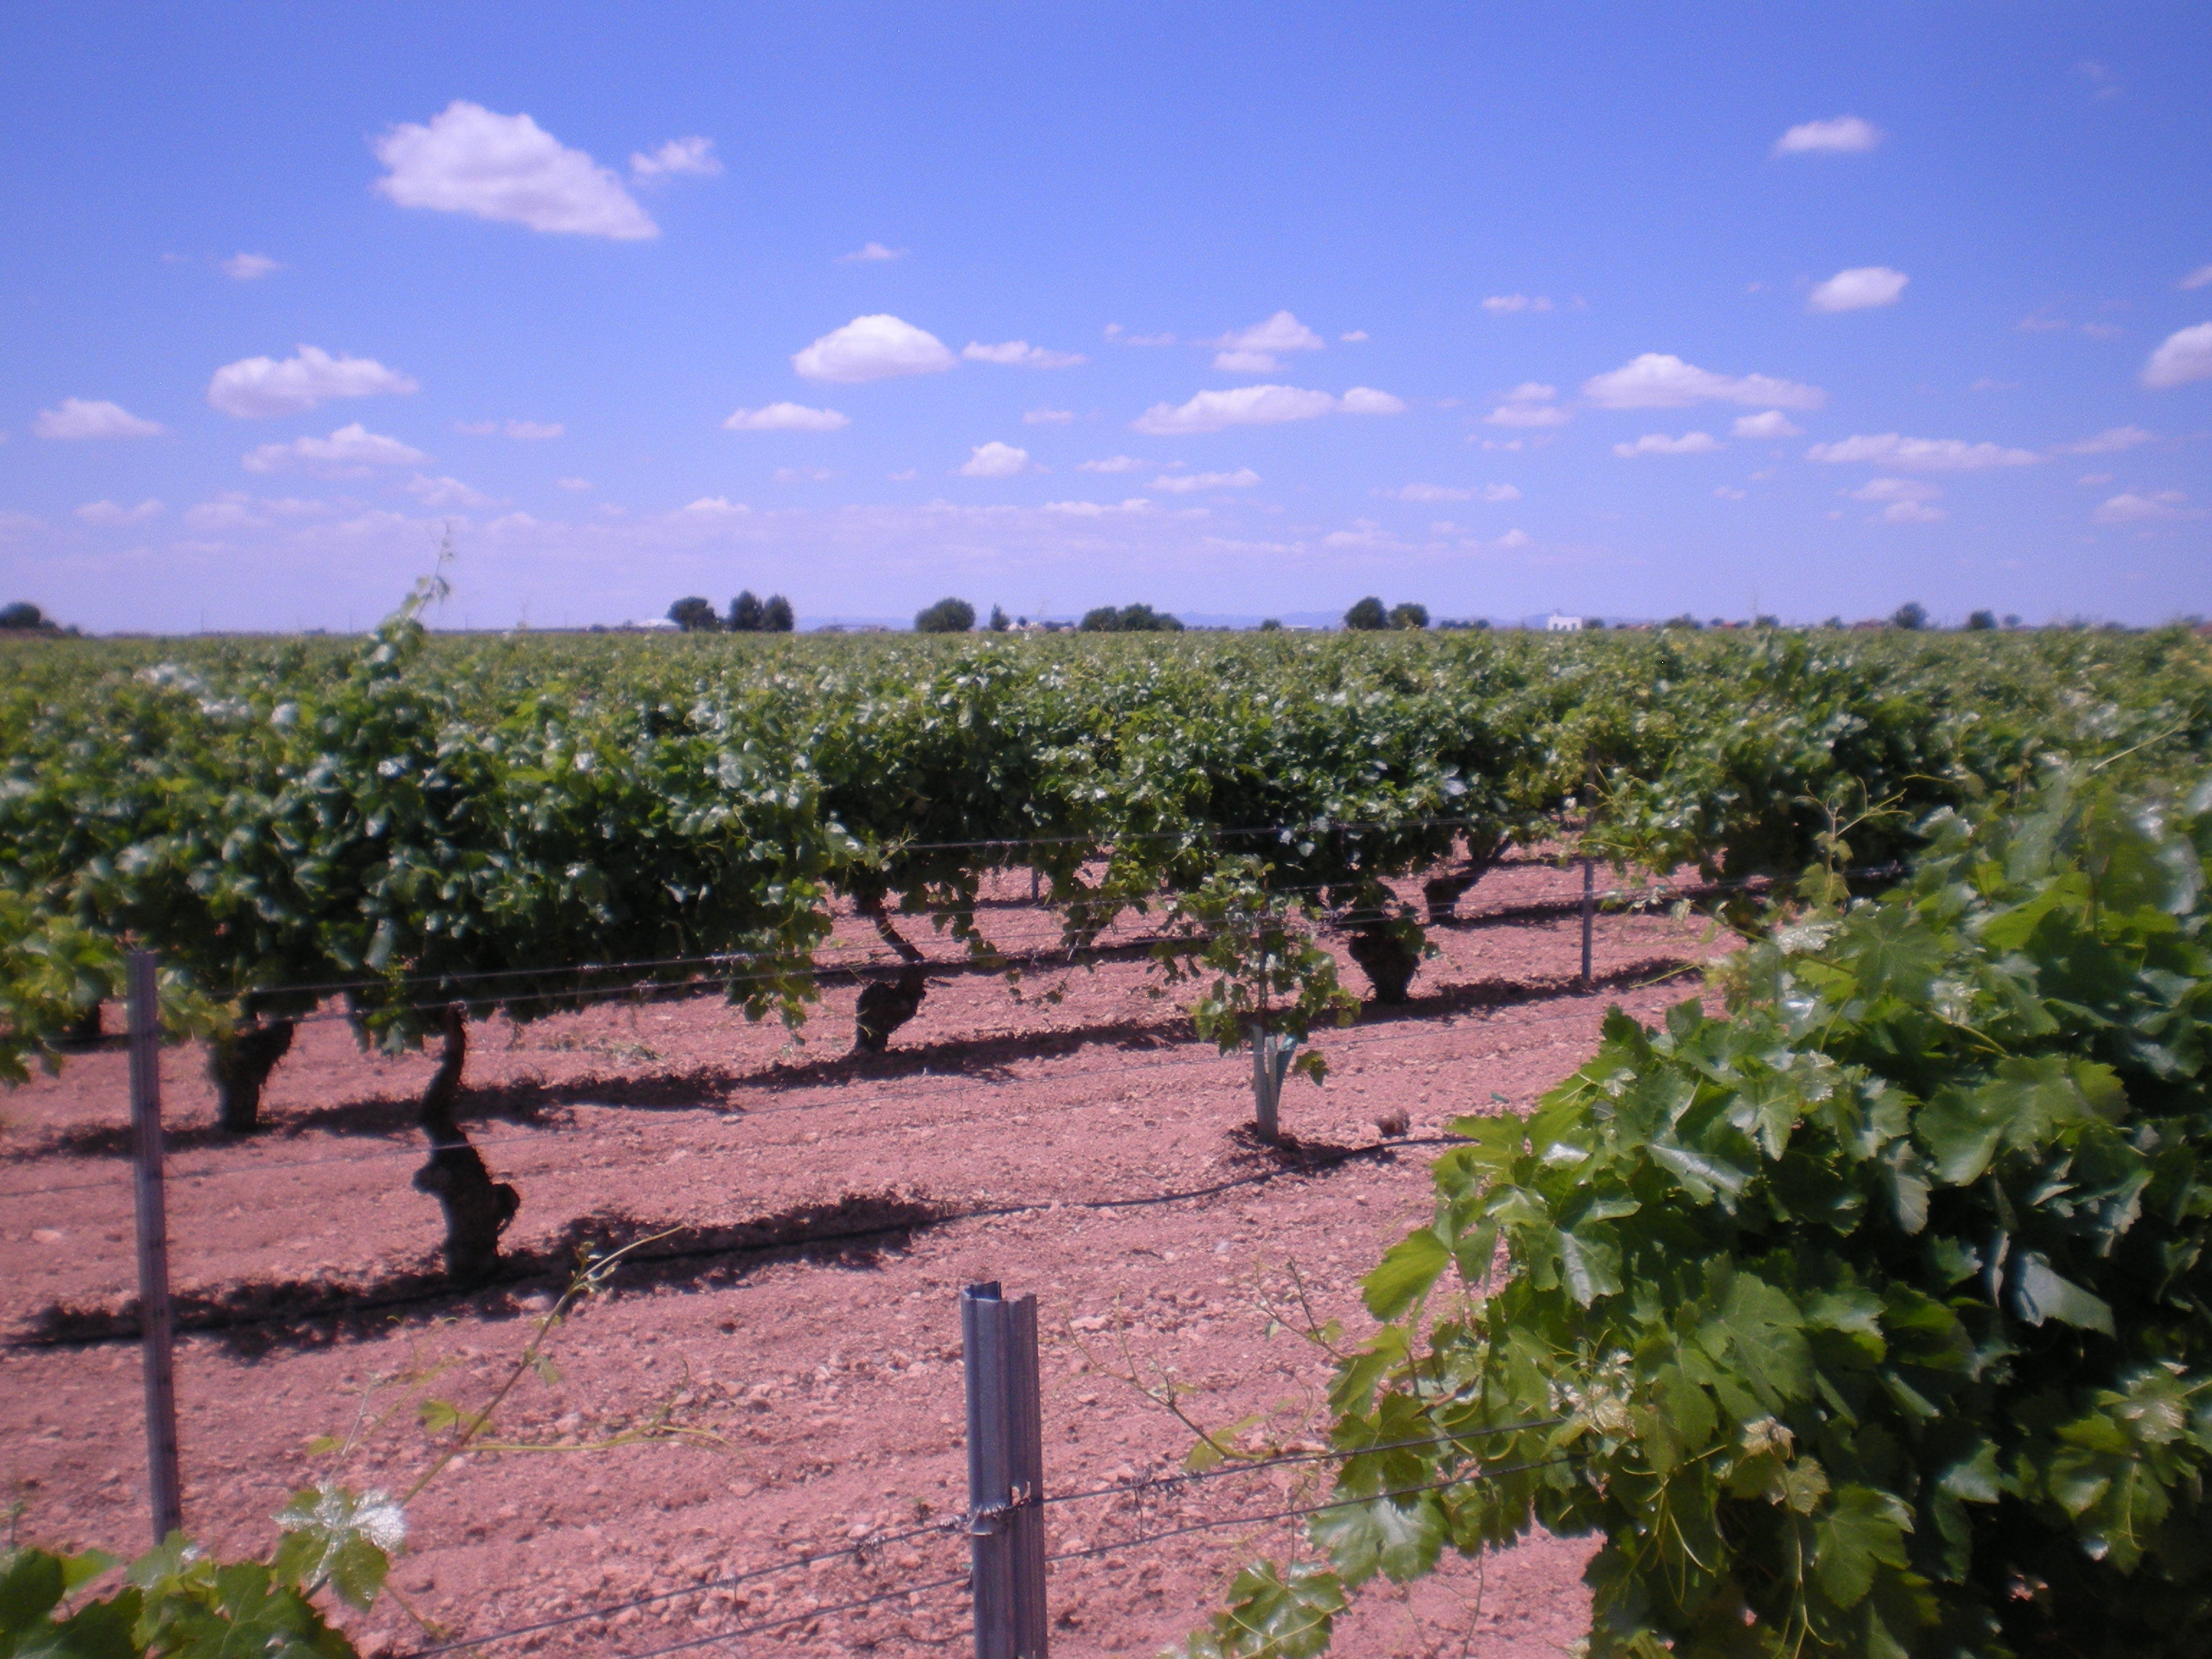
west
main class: Cropland
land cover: Vineyards
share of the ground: 25 - 50 %
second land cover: Other bare soil
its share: > 75 %
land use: Agriculture (excluding fallow land and kitchen gardens)
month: June
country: ES
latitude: 39.2274
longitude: -3.0457
